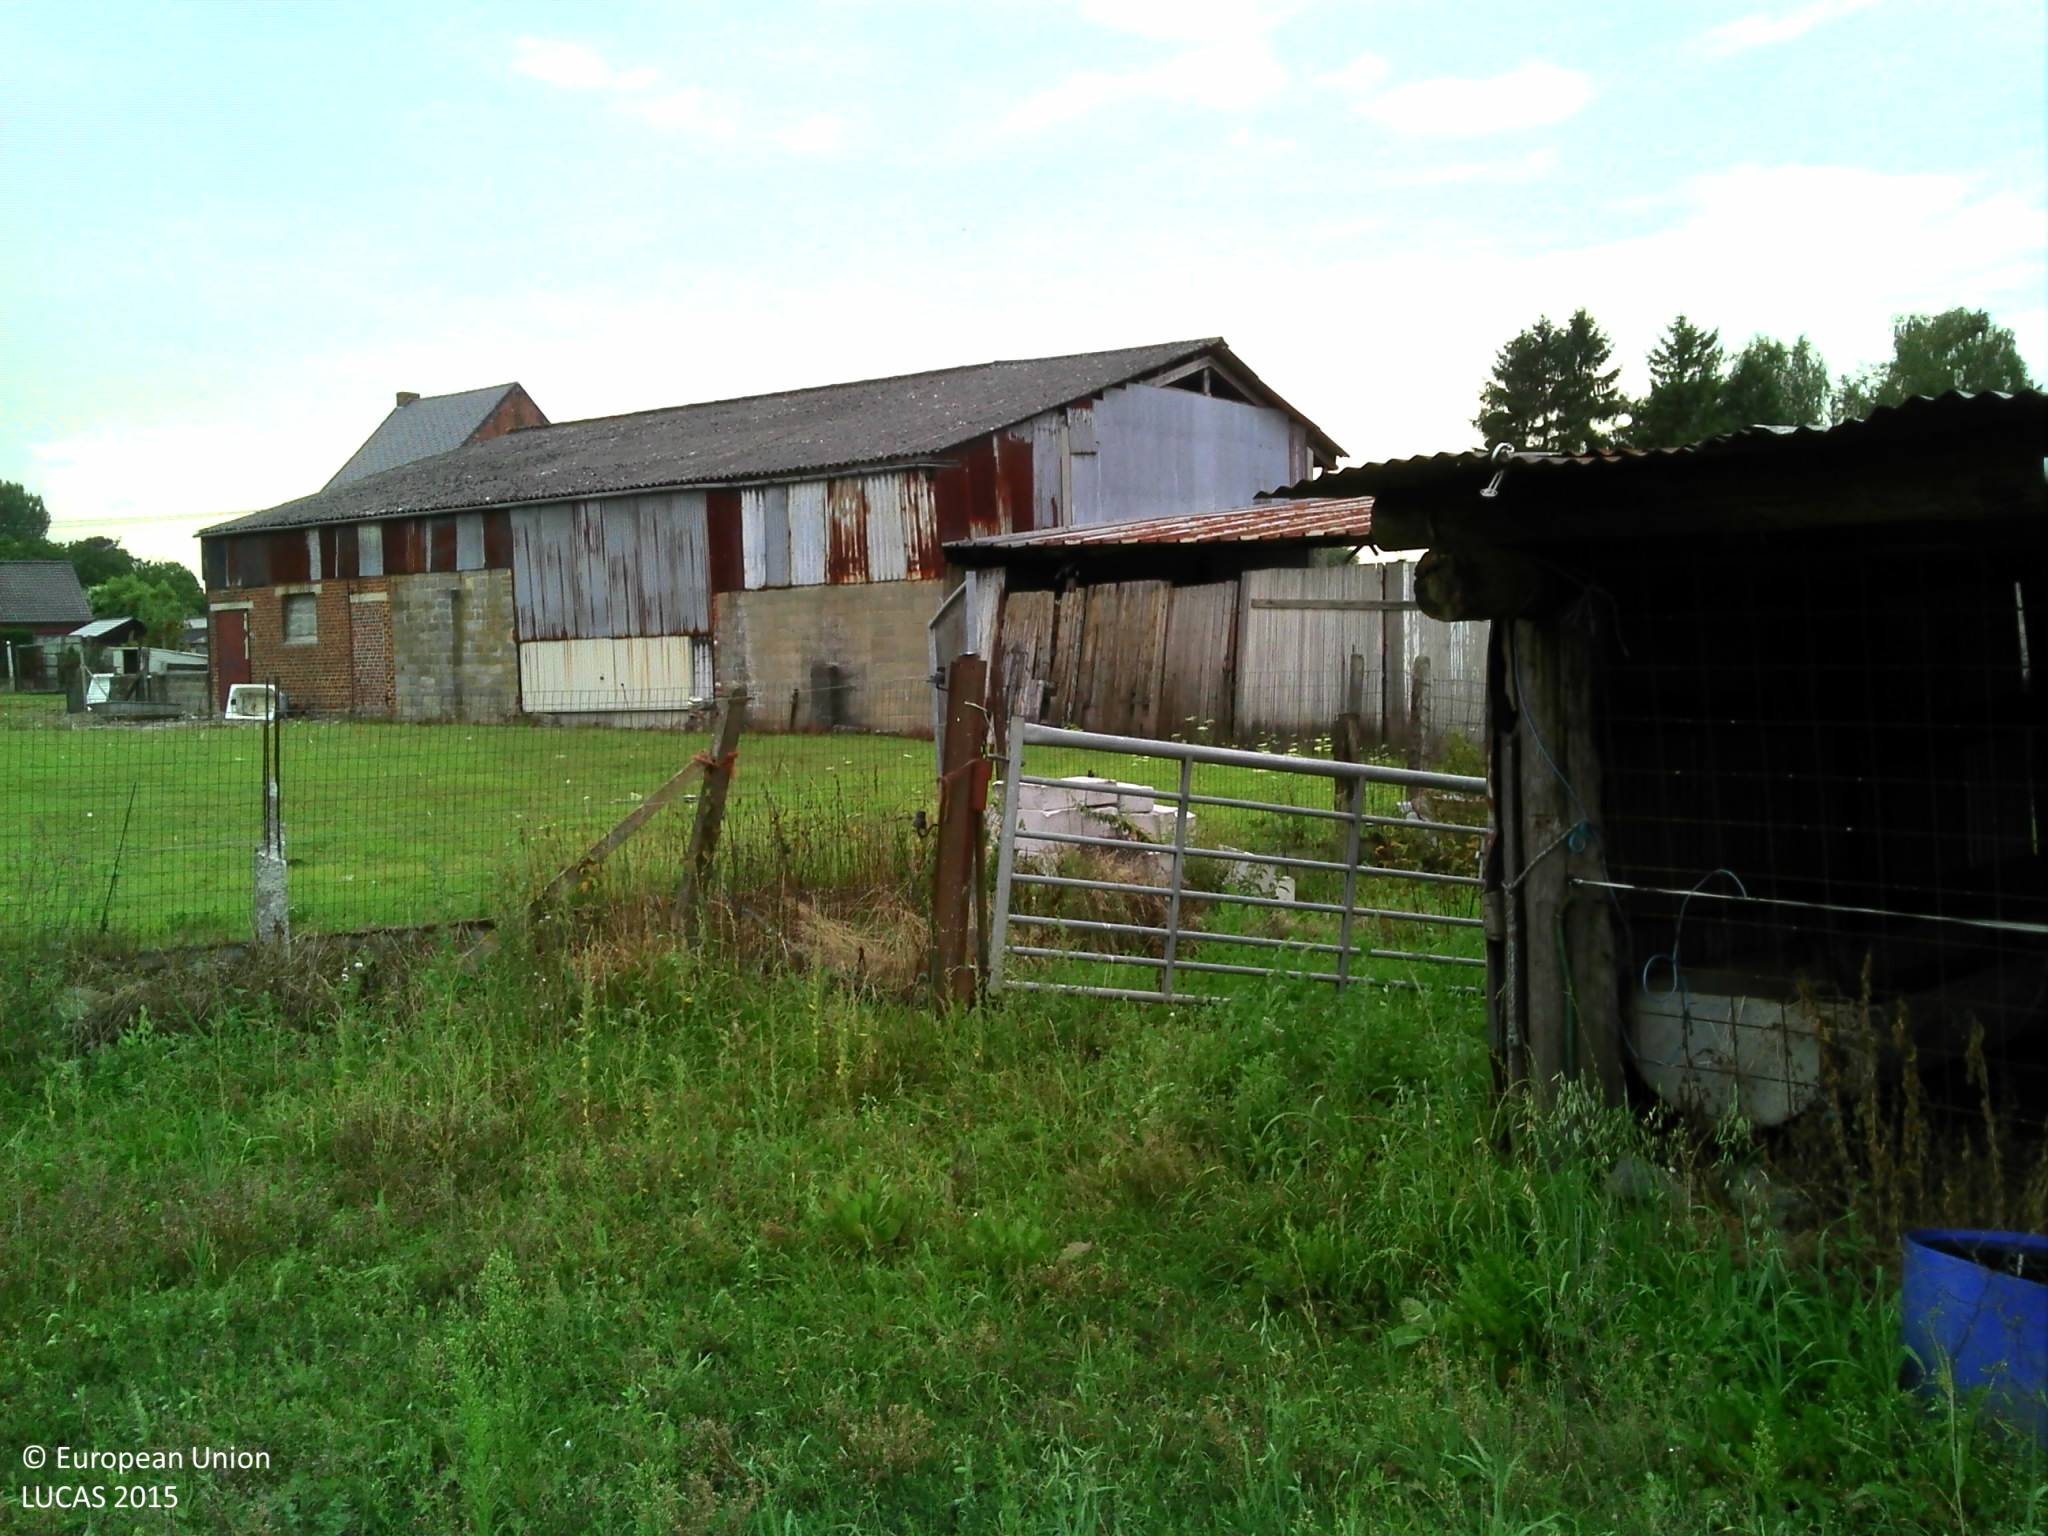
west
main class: Grassland
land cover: Grassland without tree/shrub cover
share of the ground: > 75 %
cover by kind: herbaceous plants 100 %
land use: Agriculture (excluding fallow land and kitchen gardens)
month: August
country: BE
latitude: 50.6863
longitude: 3.8649
